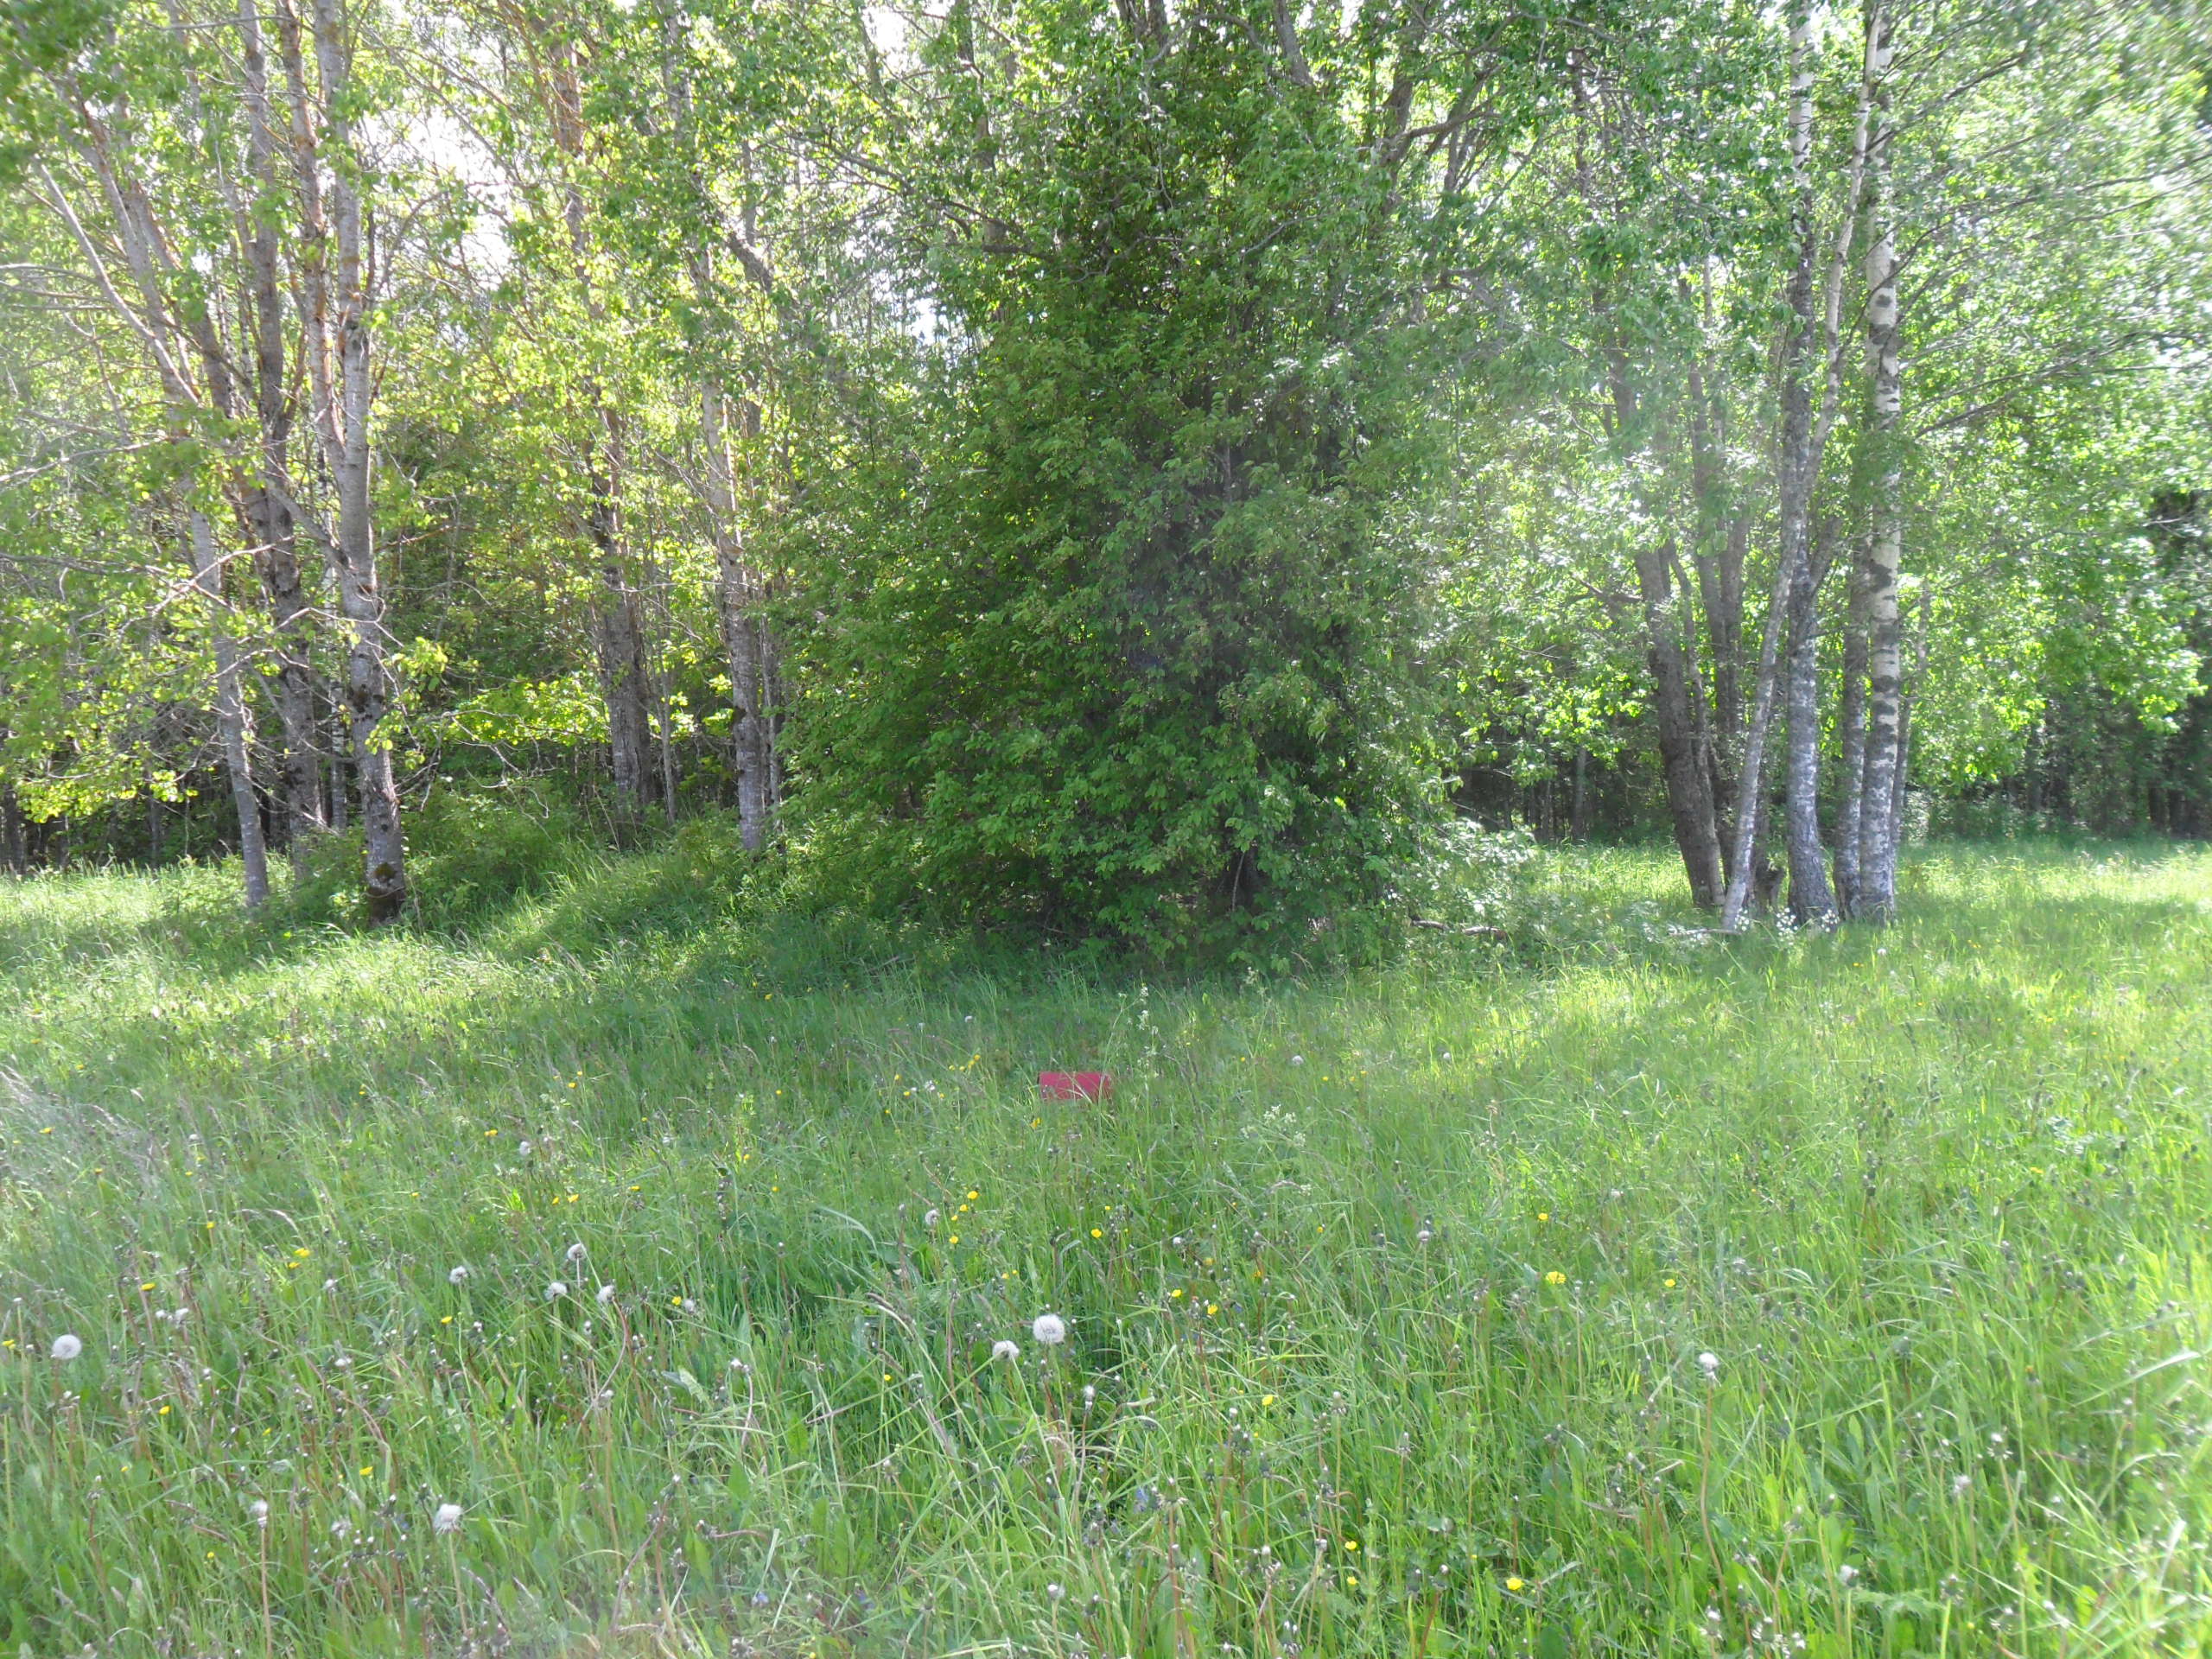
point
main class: Grassland
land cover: Grassland without tree/shrub cover
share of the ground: > 75 %
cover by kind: herbaceous plants 95 %, shrubs 5 %
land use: Agriculture (excluding fallow land and kitchen gardens)
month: June
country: LV
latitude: 57.4599
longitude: 22.4031
